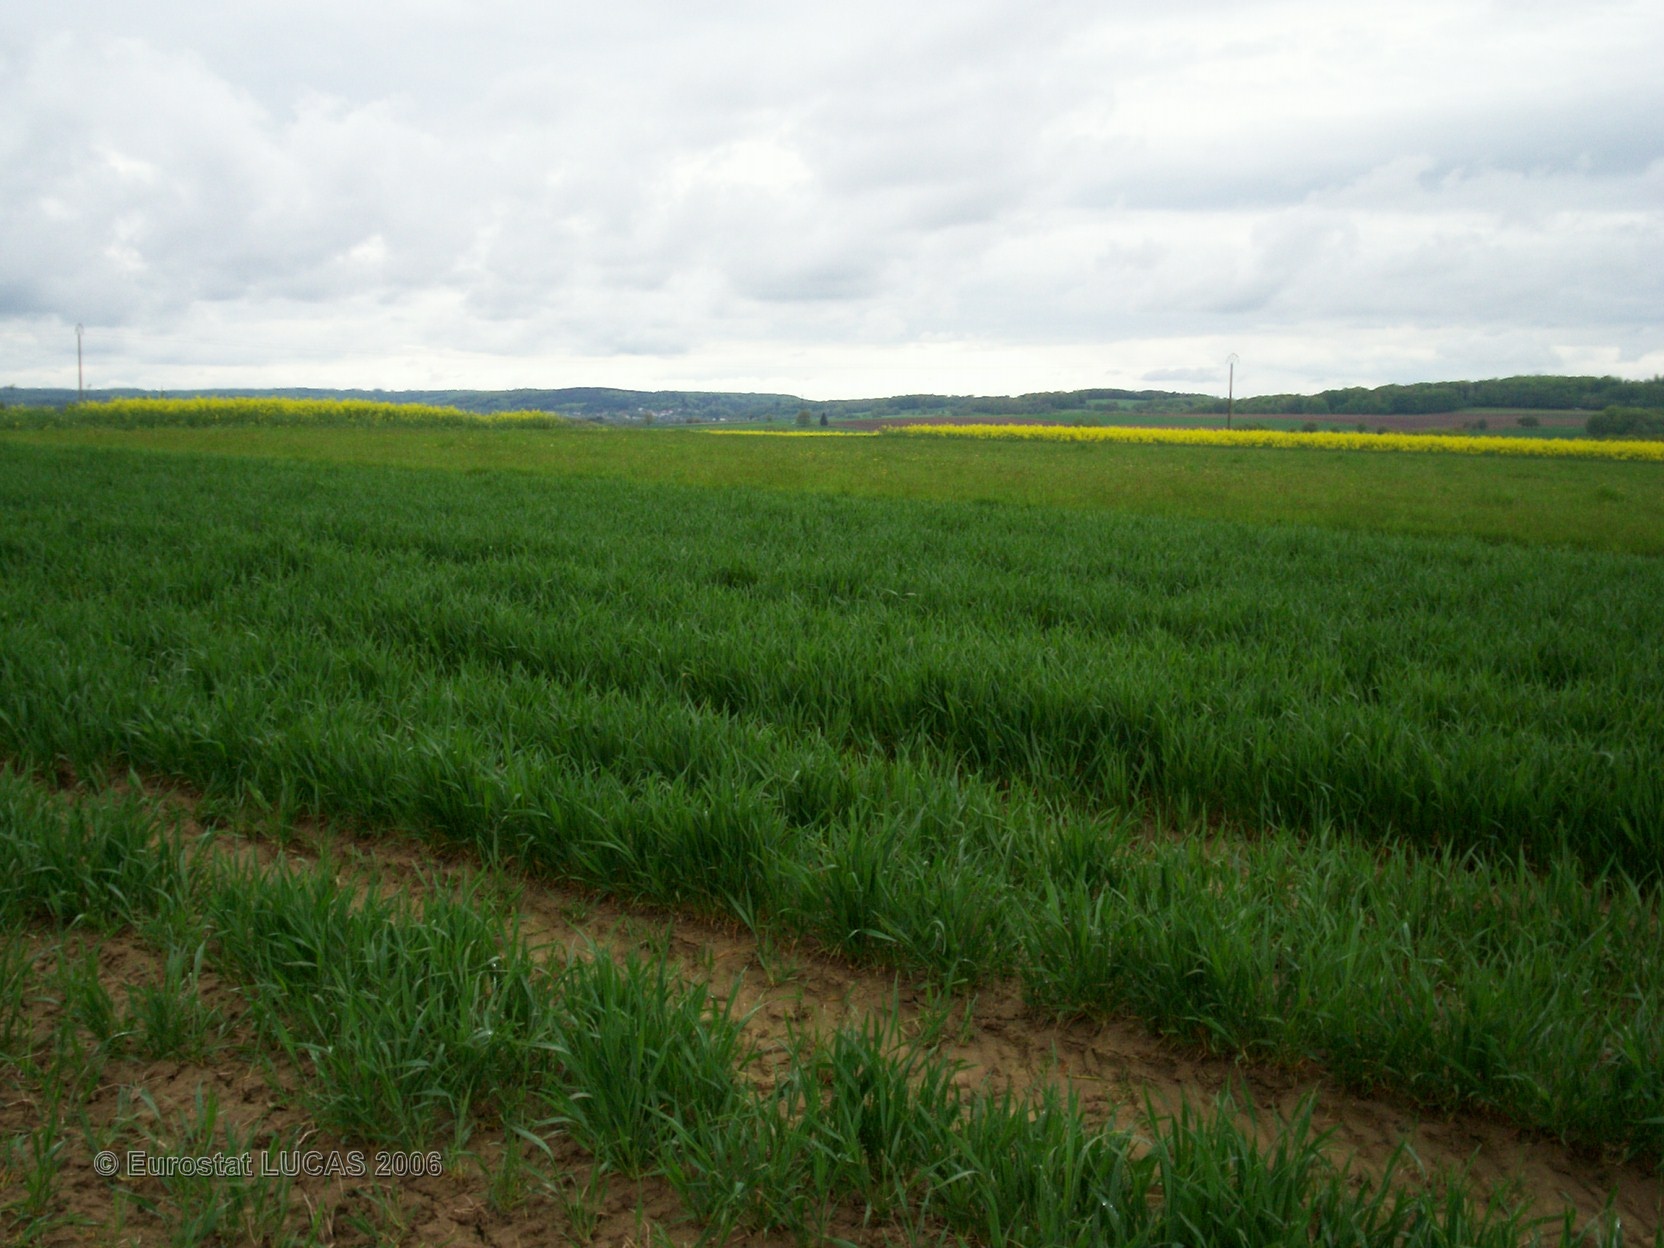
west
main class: Cropland
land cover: Common wheat
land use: Agriculture (excluding fallow land and kitchen gardens)
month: May
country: FR
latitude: 48.1086
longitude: 6.3341
